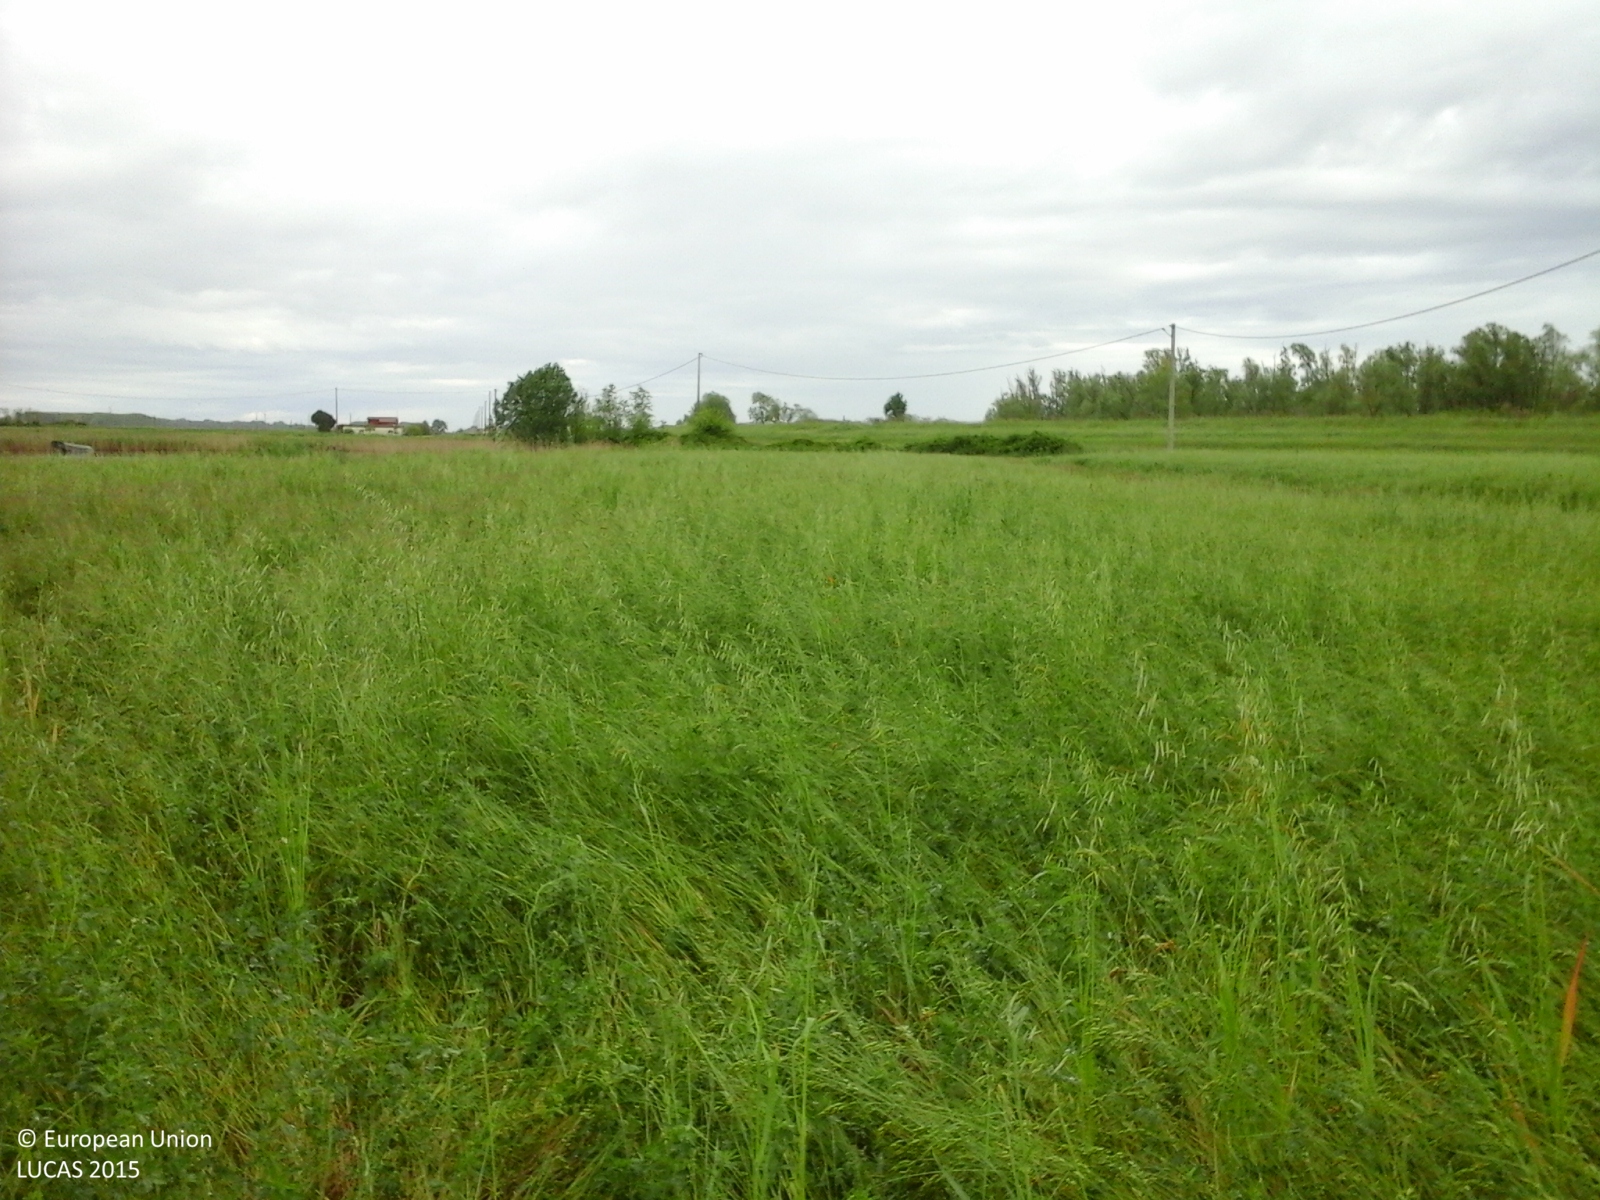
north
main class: Cropland
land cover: Lucerne
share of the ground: > 75 %
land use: Agriculture (excluding fallow land and kitchen gardens)
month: April
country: IT
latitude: 44.8666
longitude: 12.2866
